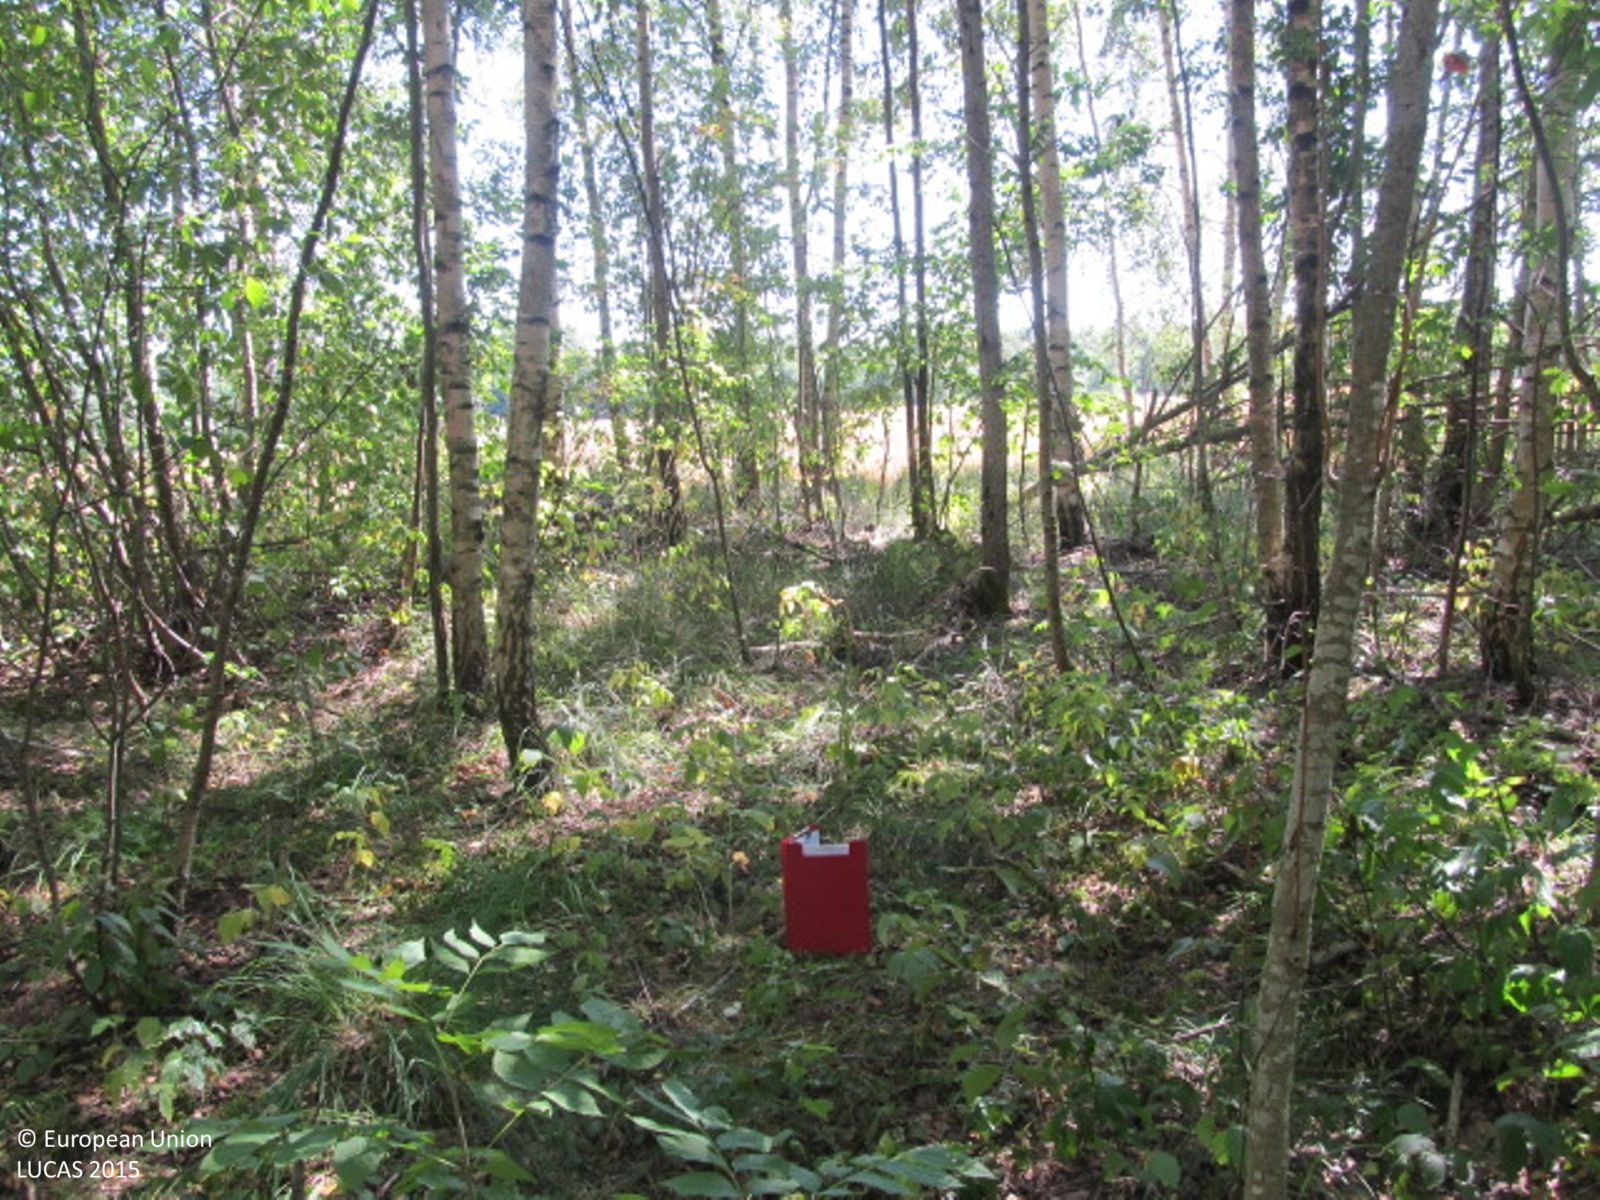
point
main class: Woodland
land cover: Broadleaved woodland
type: non-riverine alder, birch or aspen forest
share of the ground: > 75 %
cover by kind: broadleaved forest trees 85 %, herbaceous plants 10 %, shrubs 5 %
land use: Forestry
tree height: > 5 m
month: August
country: LT
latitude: 56.1385
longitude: 22.4981
